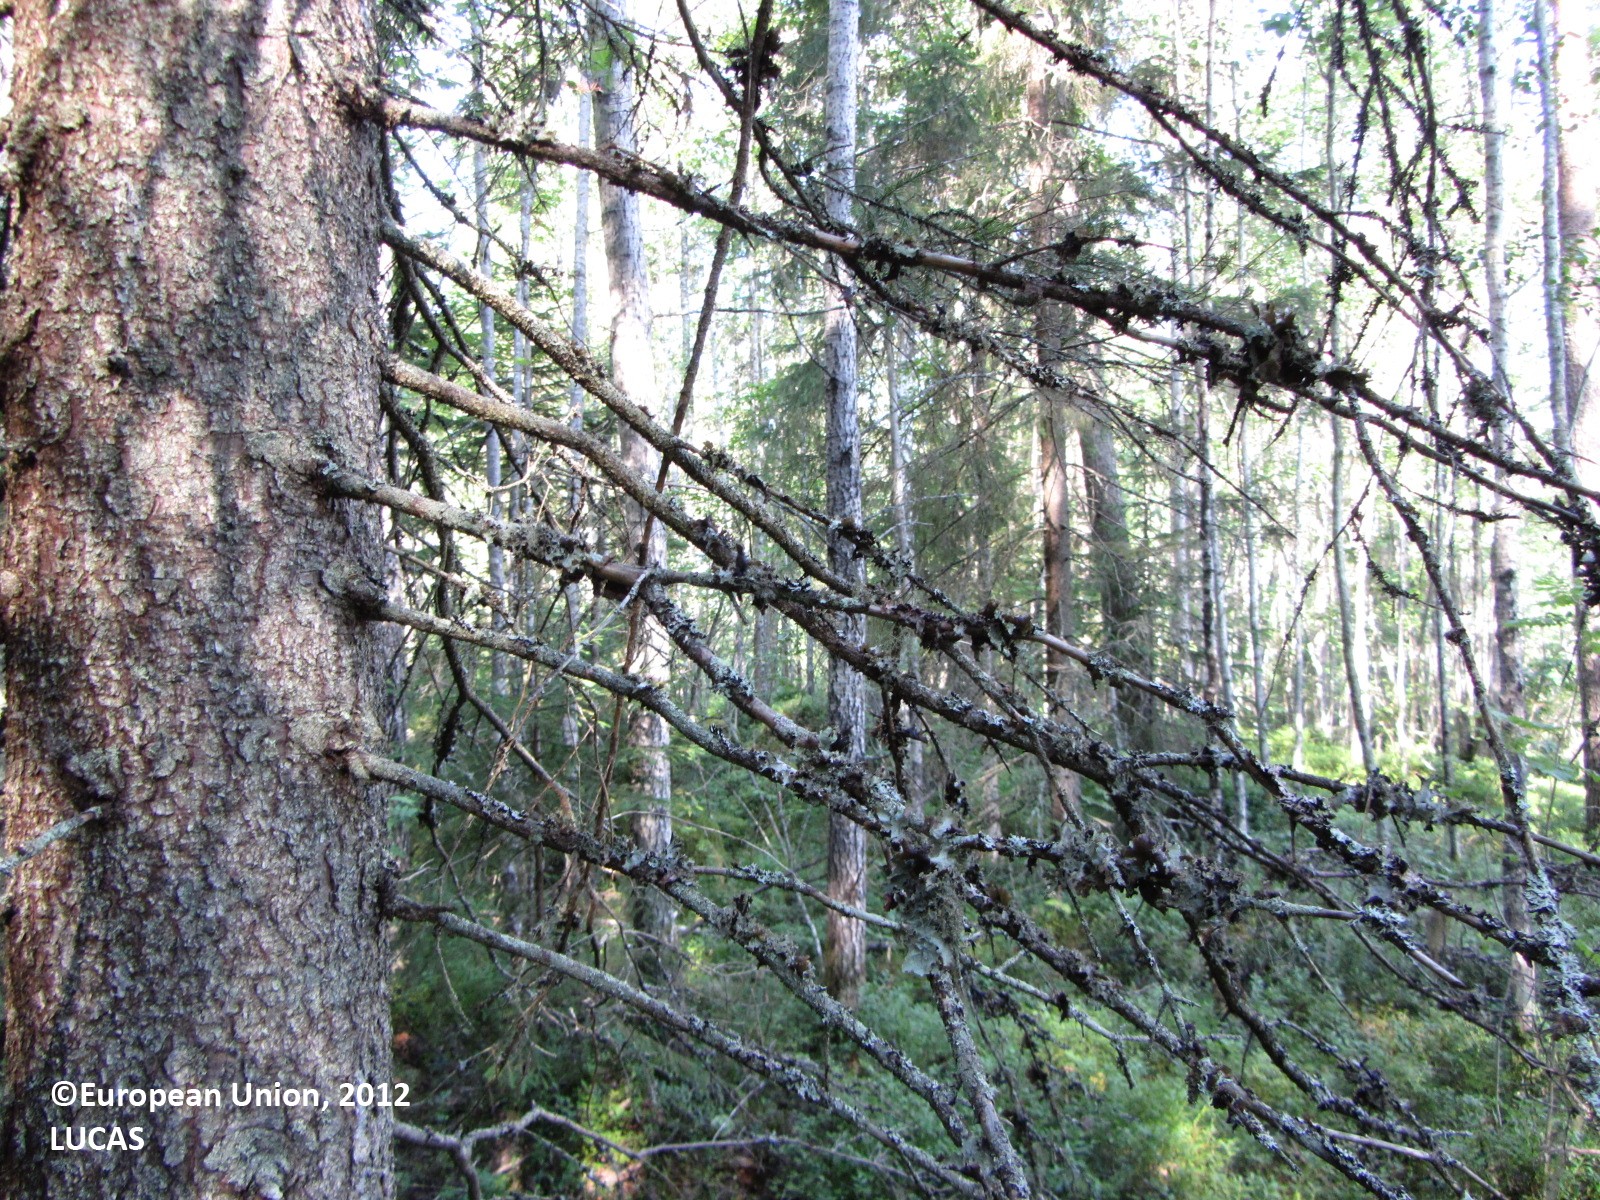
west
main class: Woodland
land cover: Other coniferous woodland
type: boreal forest
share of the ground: > 75 %
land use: Forestry
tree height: > 5 m
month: July
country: FI
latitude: 63.6722
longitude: 24.6935
